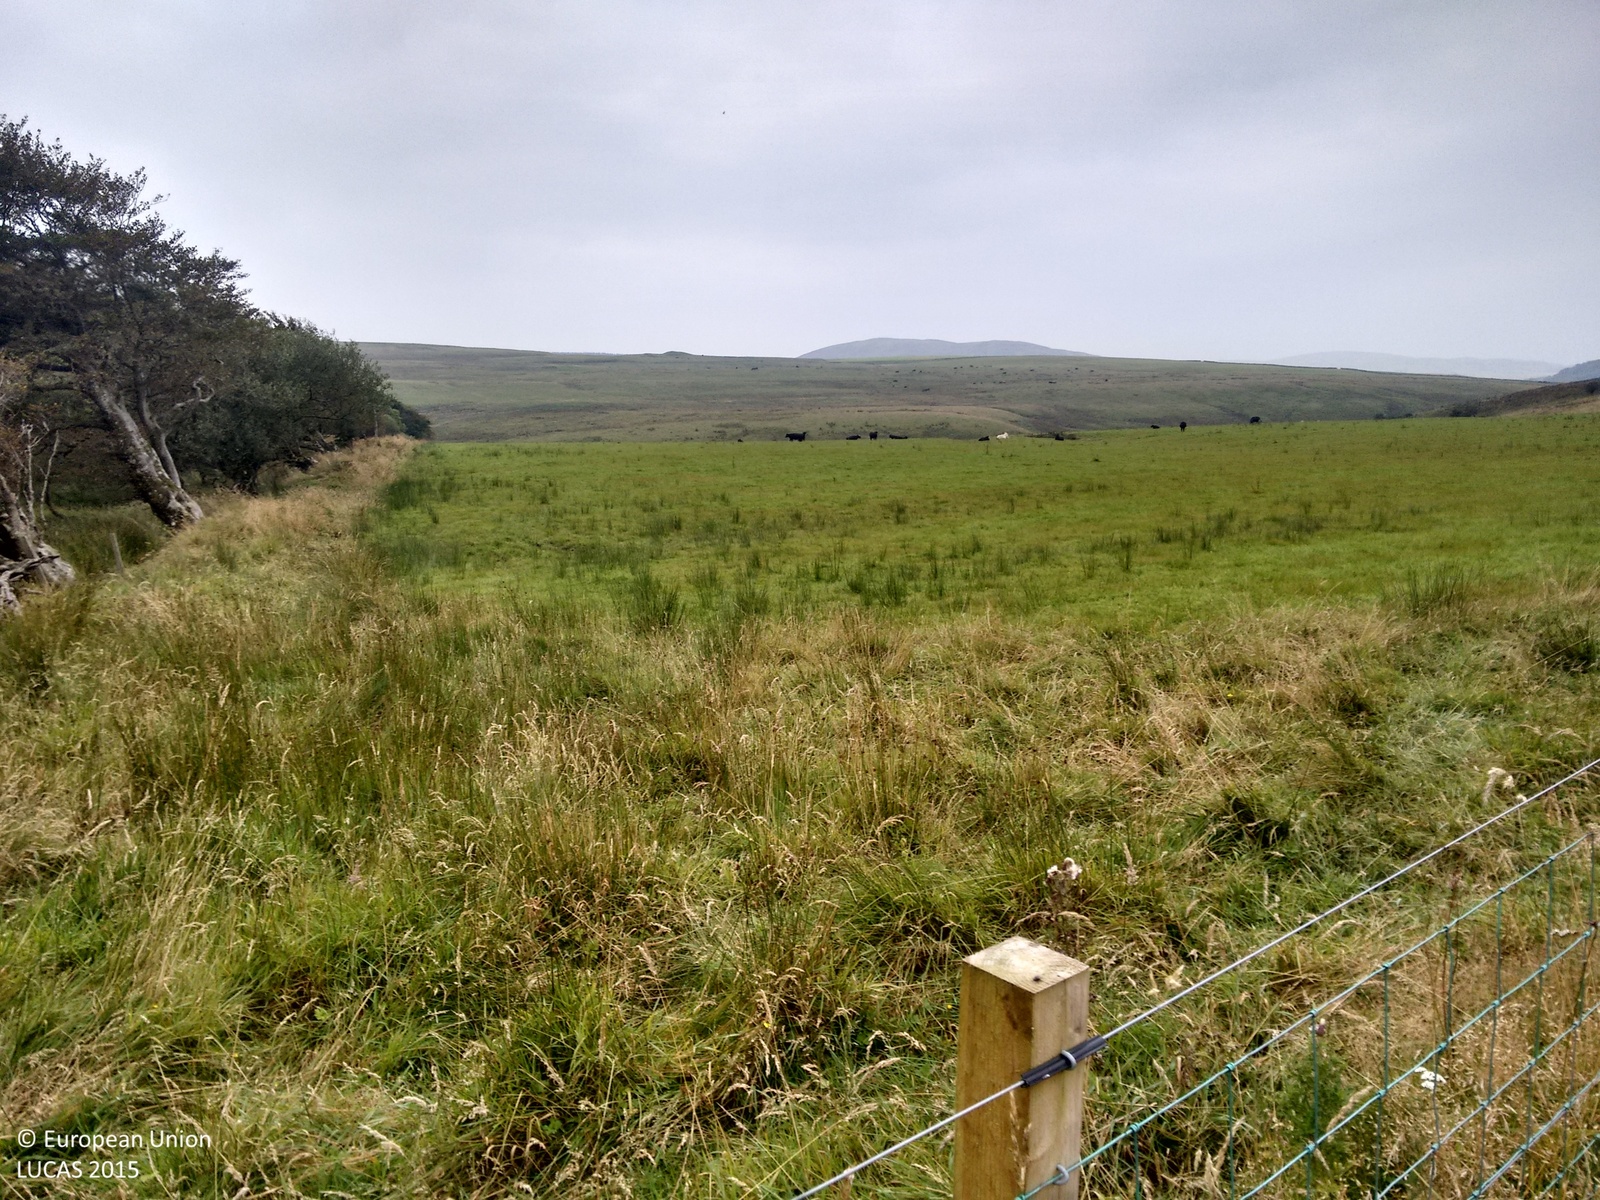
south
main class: Grassland
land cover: Grassland without tree/shrub cover
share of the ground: > 75 %
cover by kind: herbaceous plants 100 %
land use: Agriculture (excluding fallow land and kitchen gardens)
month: September
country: GB
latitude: 55.1876
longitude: -4.8578
